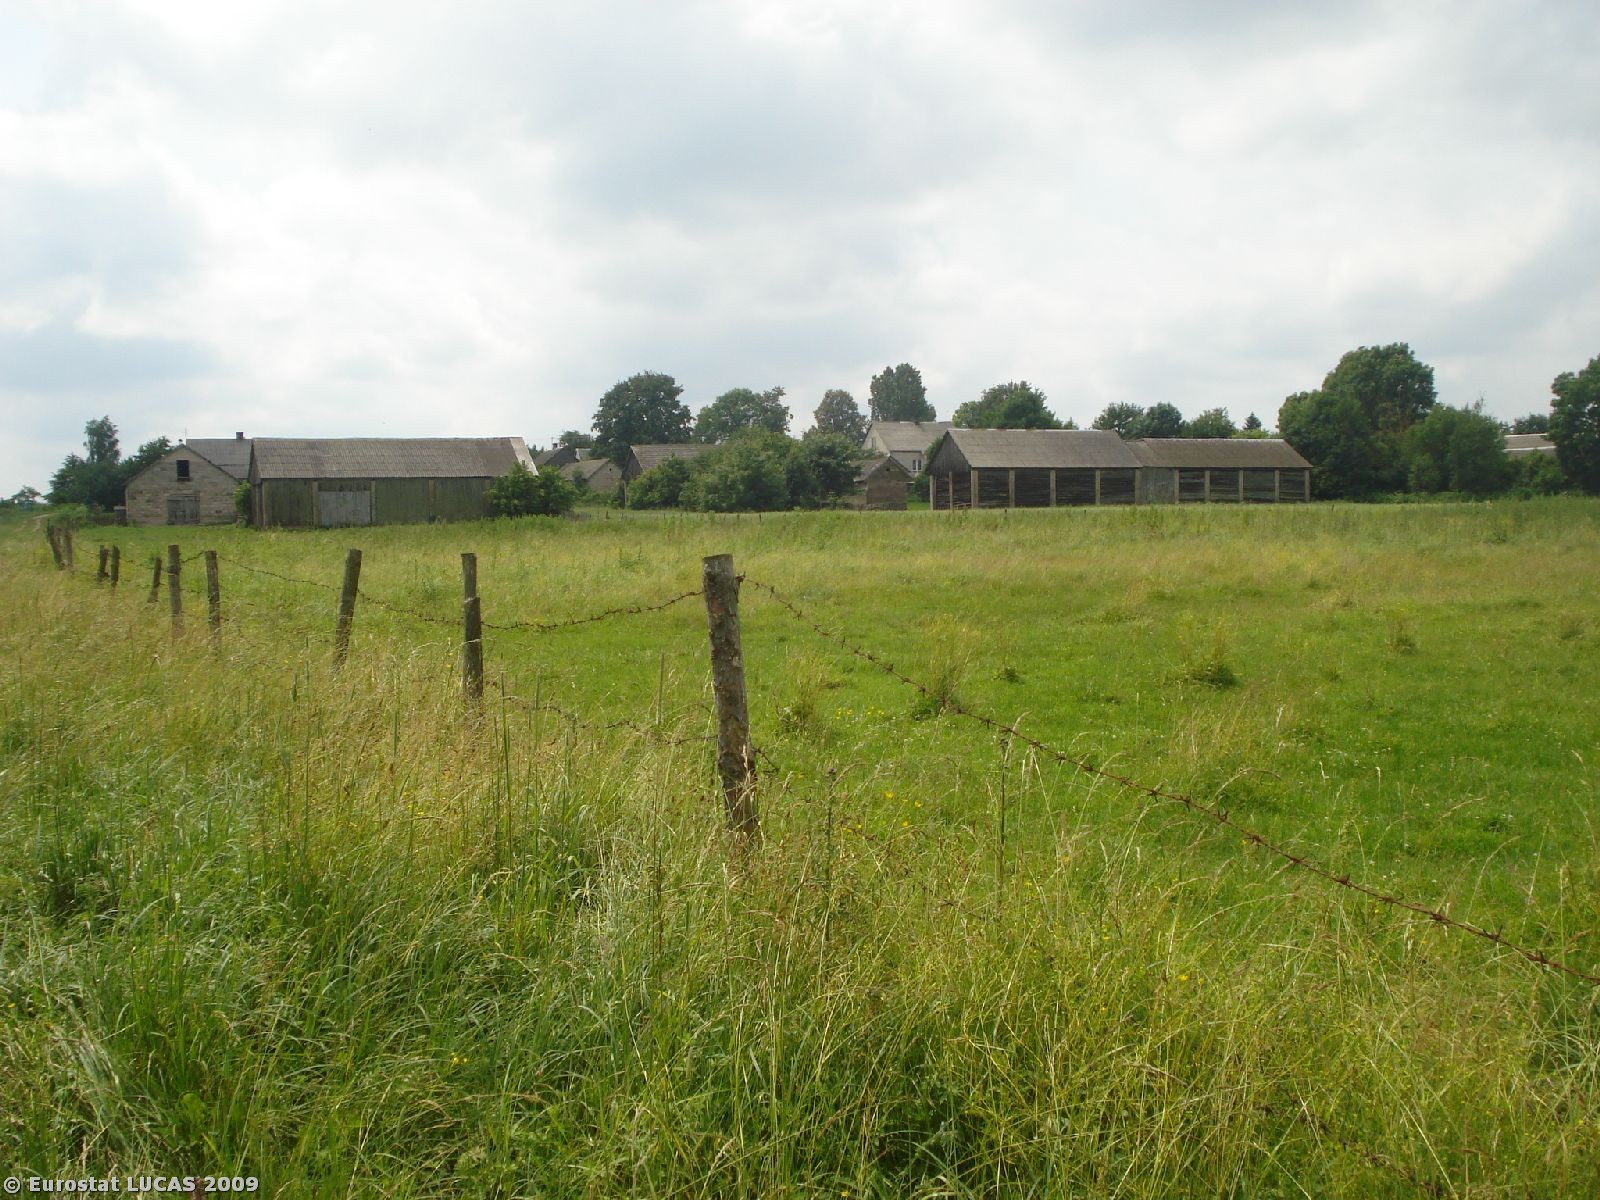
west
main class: Water areas
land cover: Inland running water
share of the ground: > 75 %
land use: Unused
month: January
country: PL
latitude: 52.5873
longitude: 23.1703
